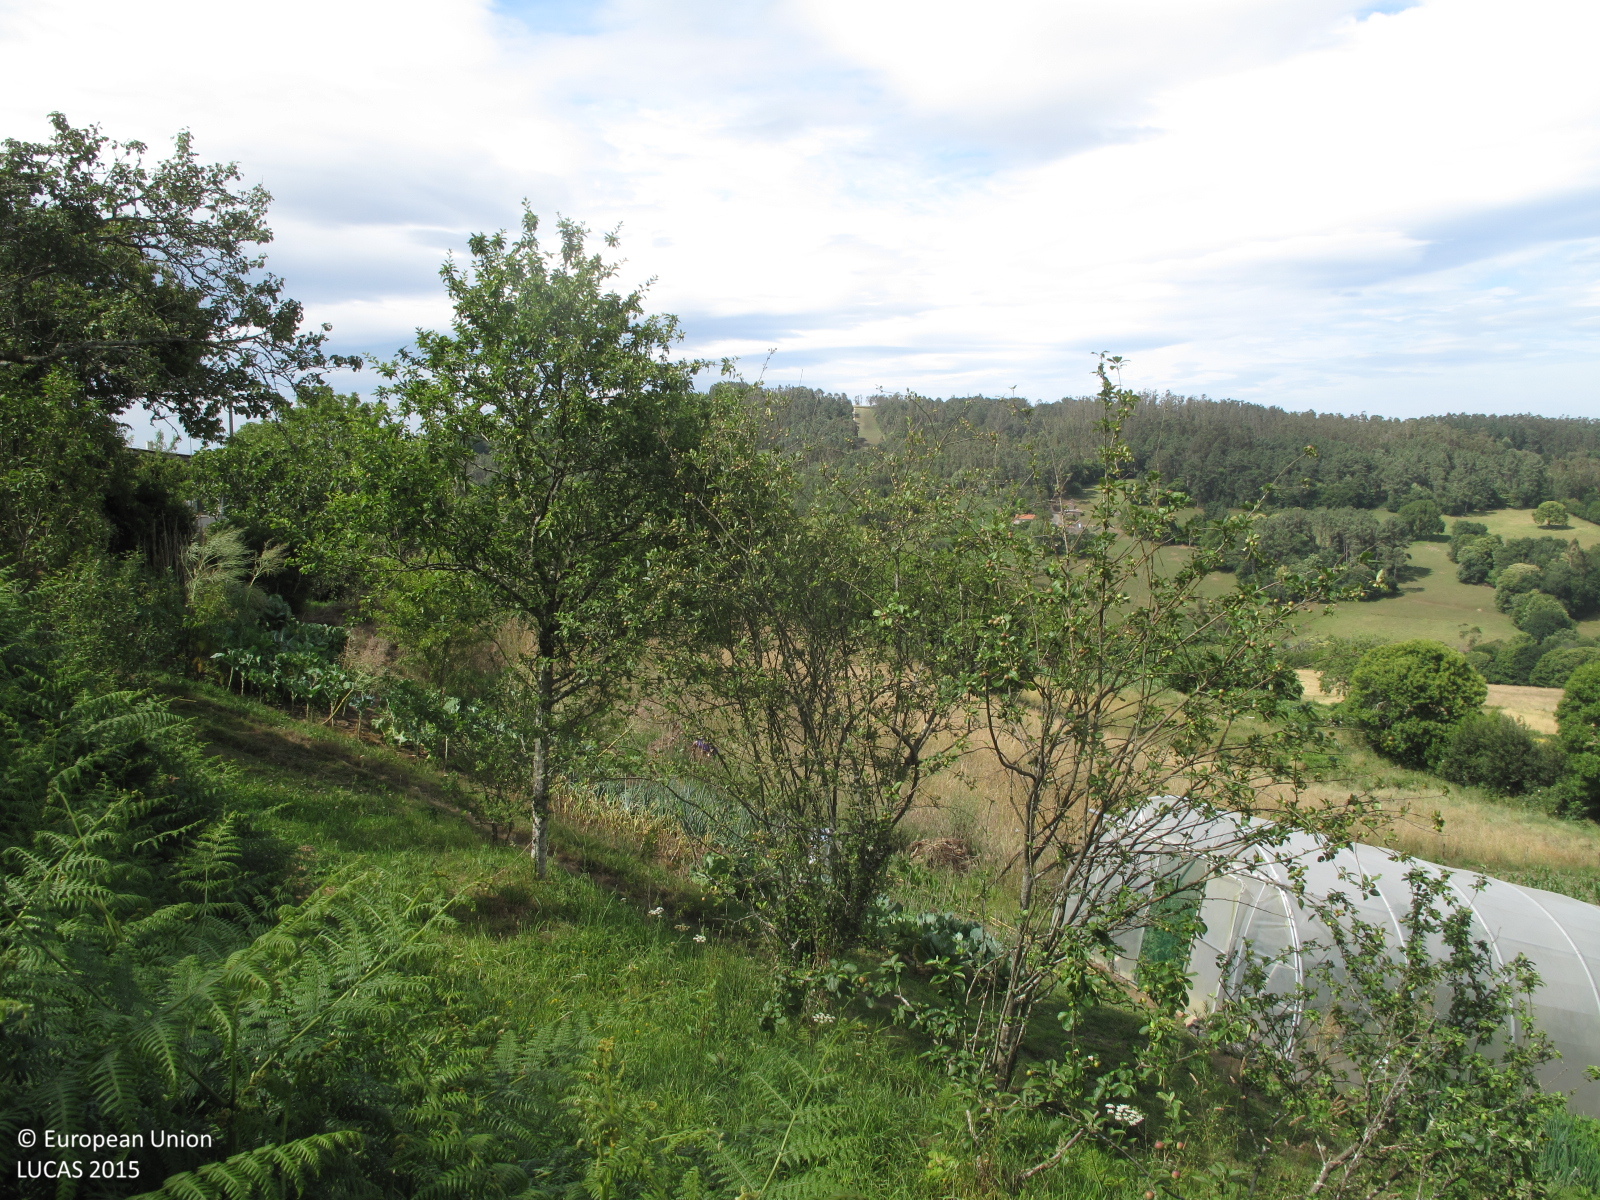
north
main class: Grassland
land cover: Grassland with sparse tree/shrub cover
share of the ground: > 75 %
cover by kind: herbaceous plants 90 %, broadleaved forest trees 5 %, shrubs 5 %
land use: Abandoned areas
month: July
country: ES
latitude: 43.2163
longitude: -8.5371
